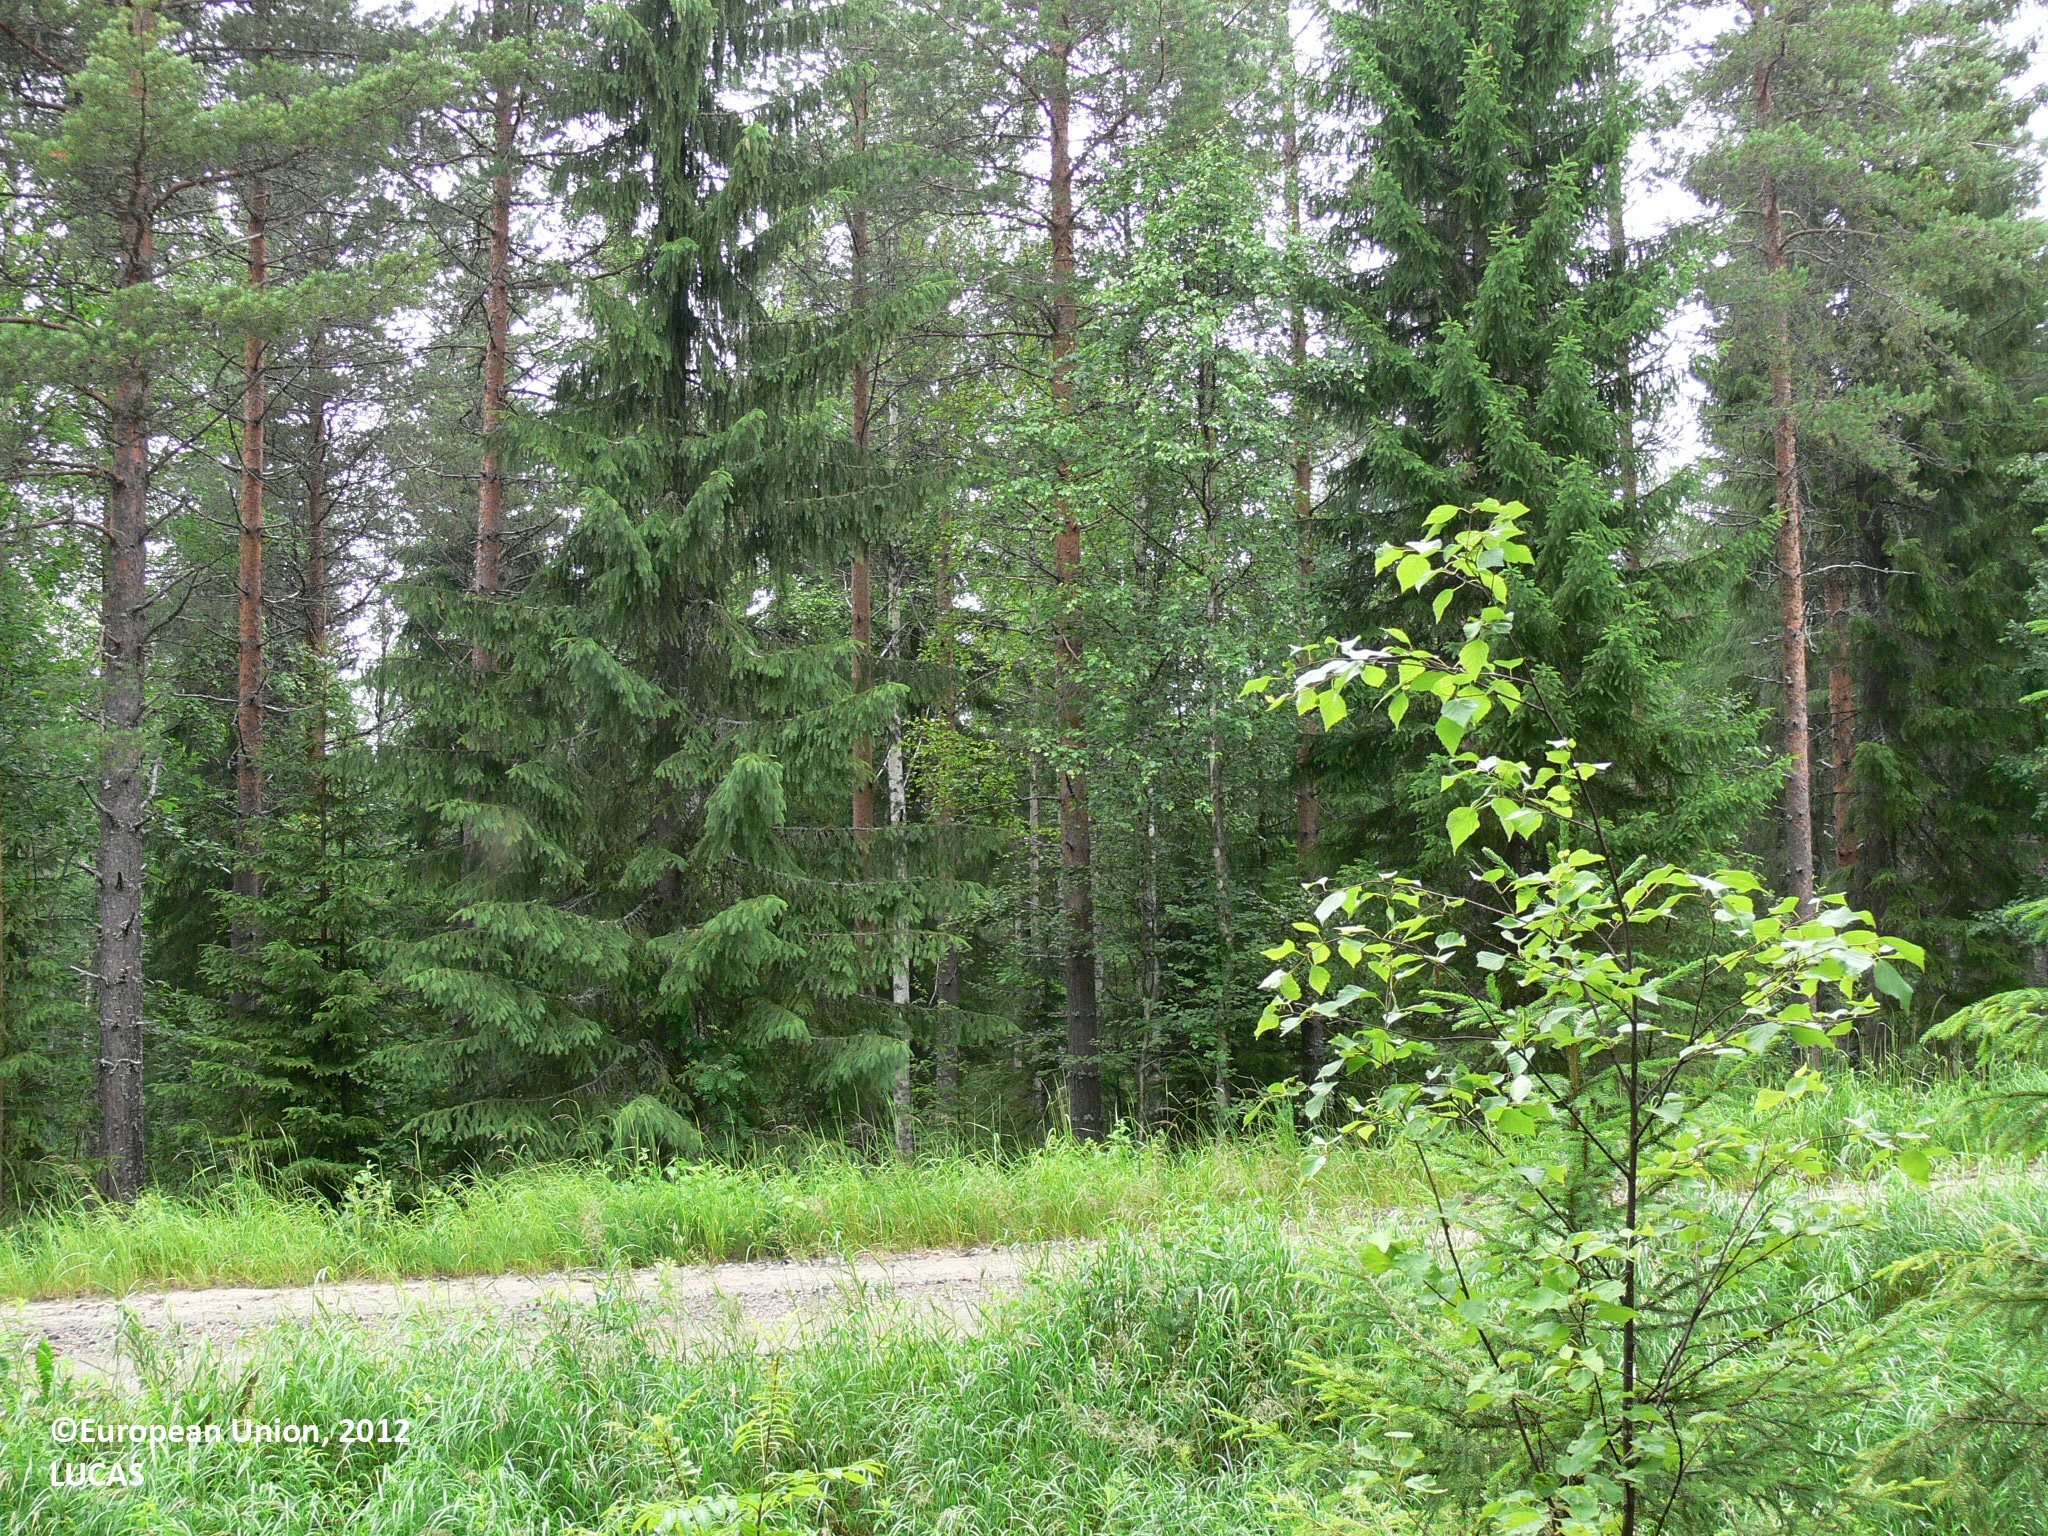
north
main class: Woodland
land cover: Other mixed woodland
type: boreal forest
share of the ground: > 75 %
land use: Forestry
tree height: > 5 m
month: July
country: FI
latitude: 63.2301
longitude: 30.8464
